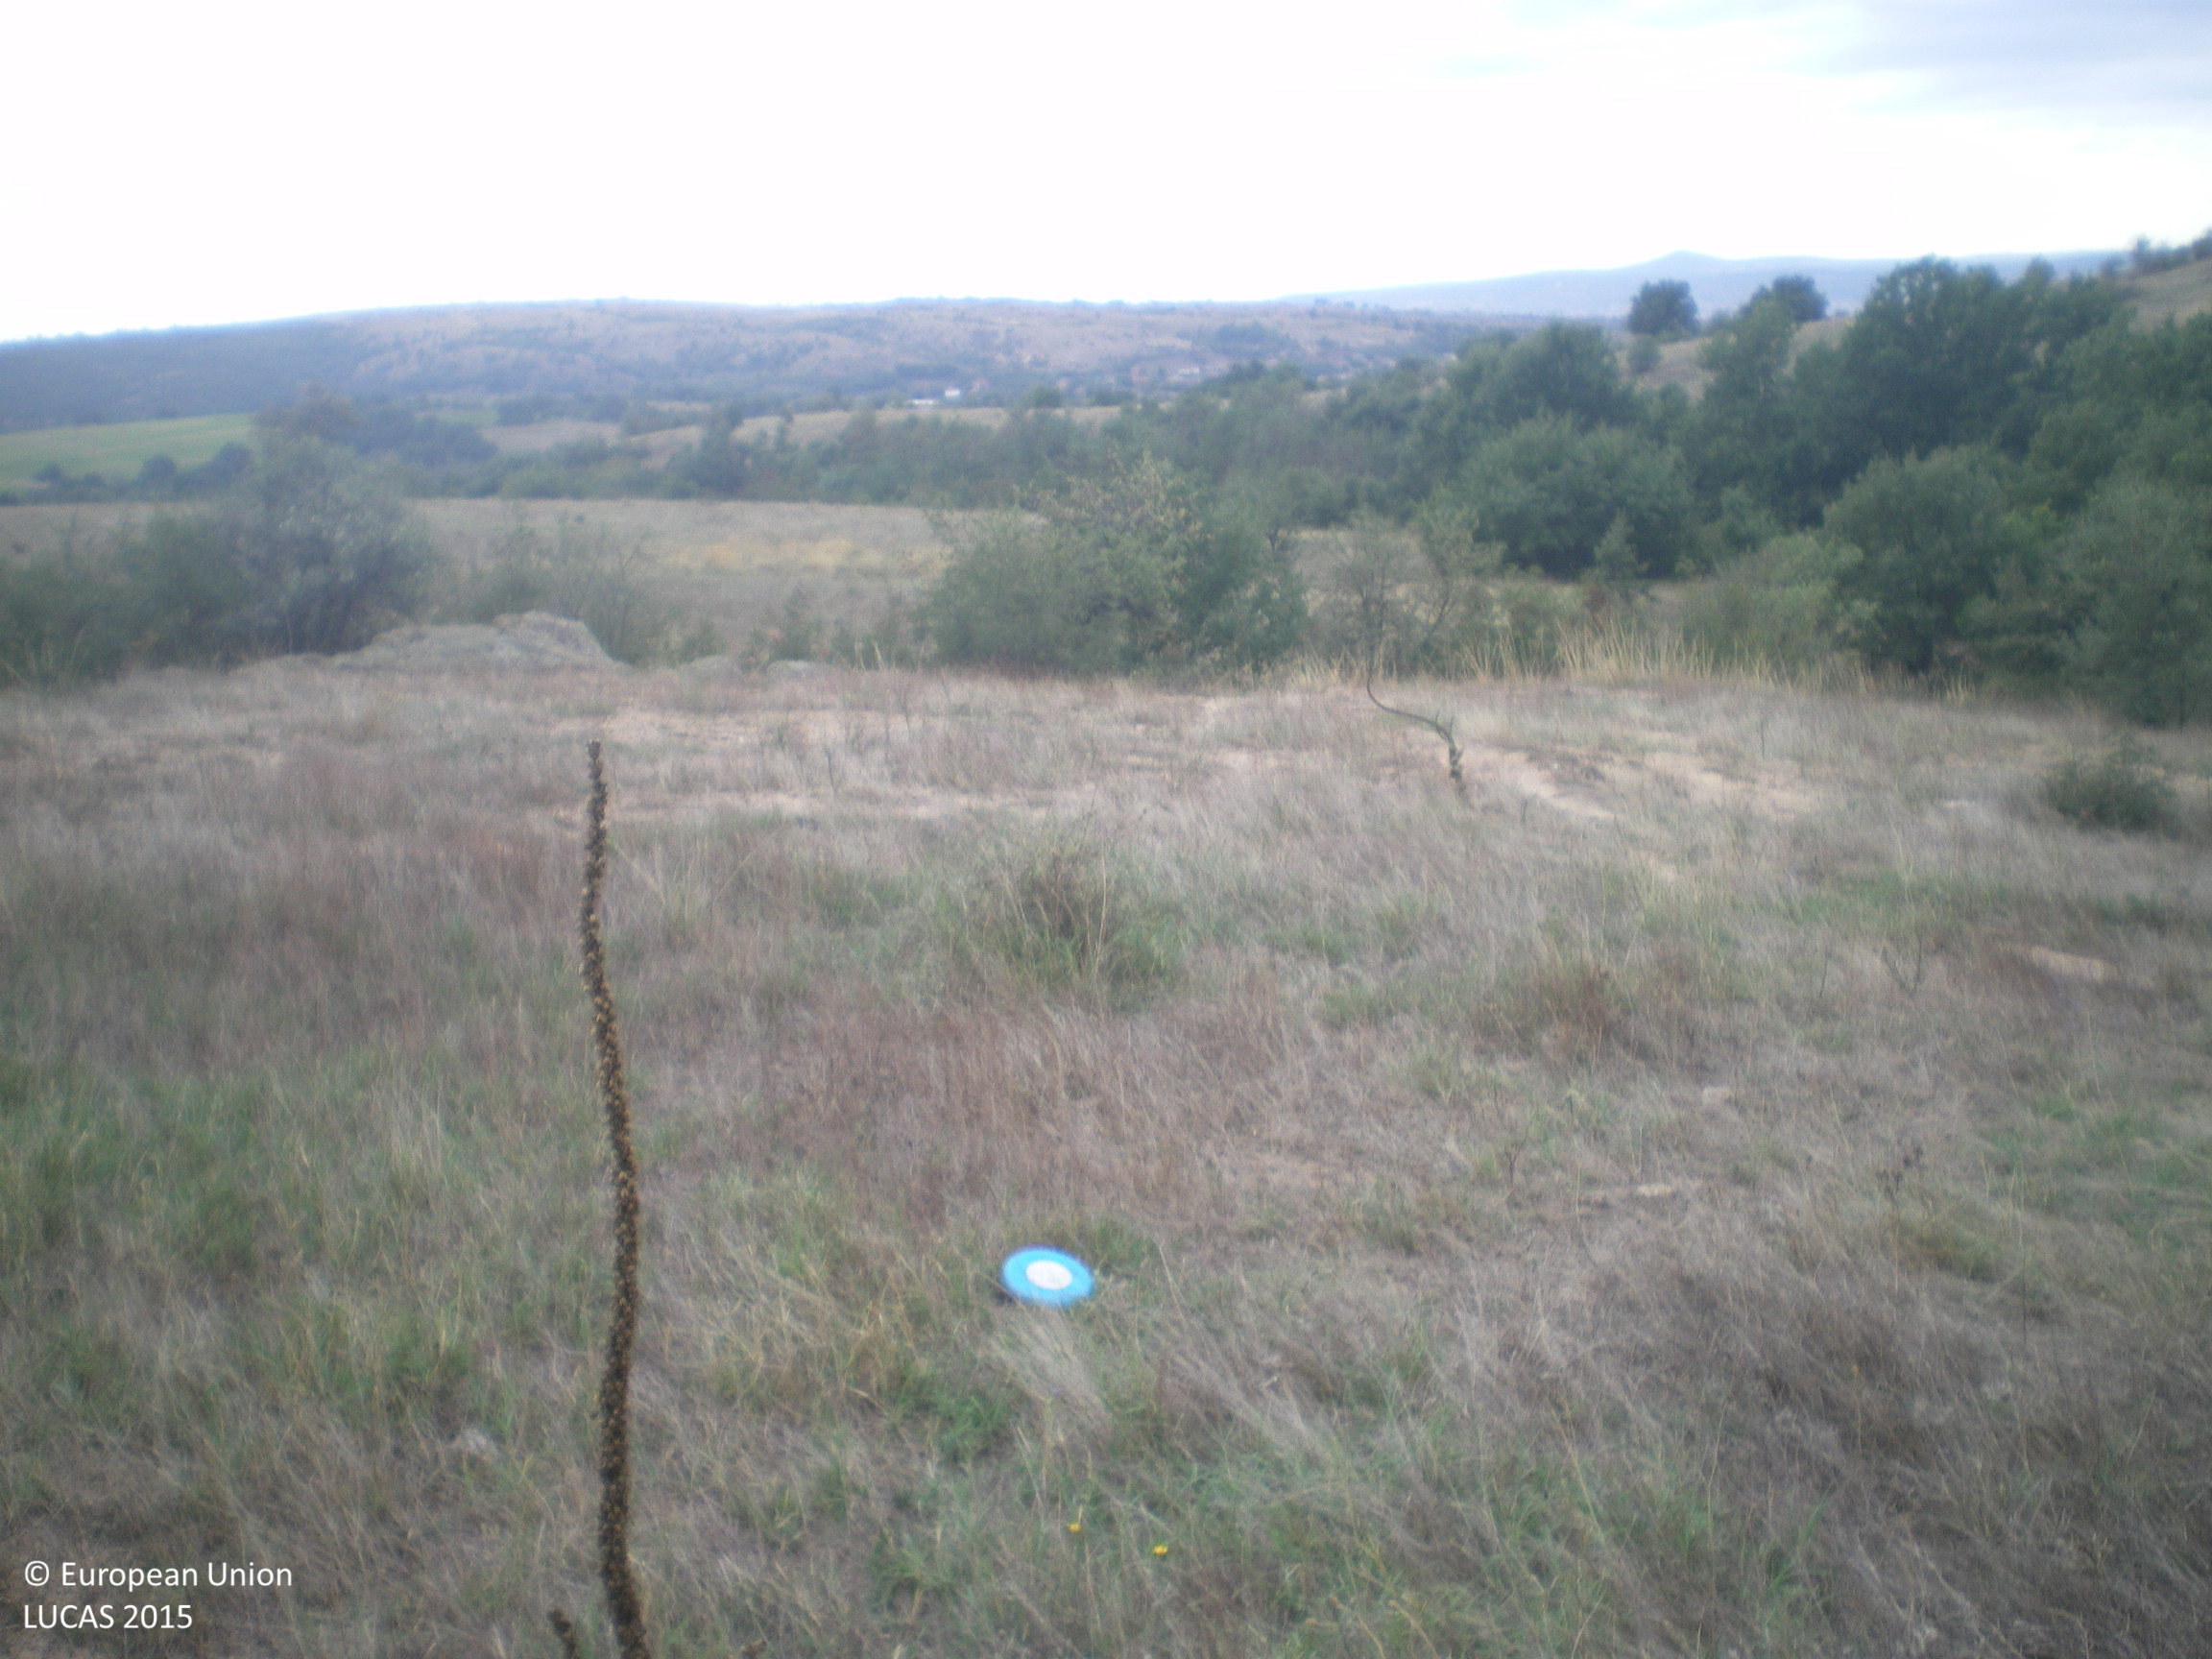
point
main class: Grassland
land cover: Grassland with sparse tree/shrub cover
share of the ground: > 75 %
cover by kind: herbaceous plants 95 %, broadleaved forest trees 5 %
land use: Semi-natural and natural areas not in use
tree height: > 5 m
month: September
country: BG
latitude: 41.9662
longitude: 25.9647
